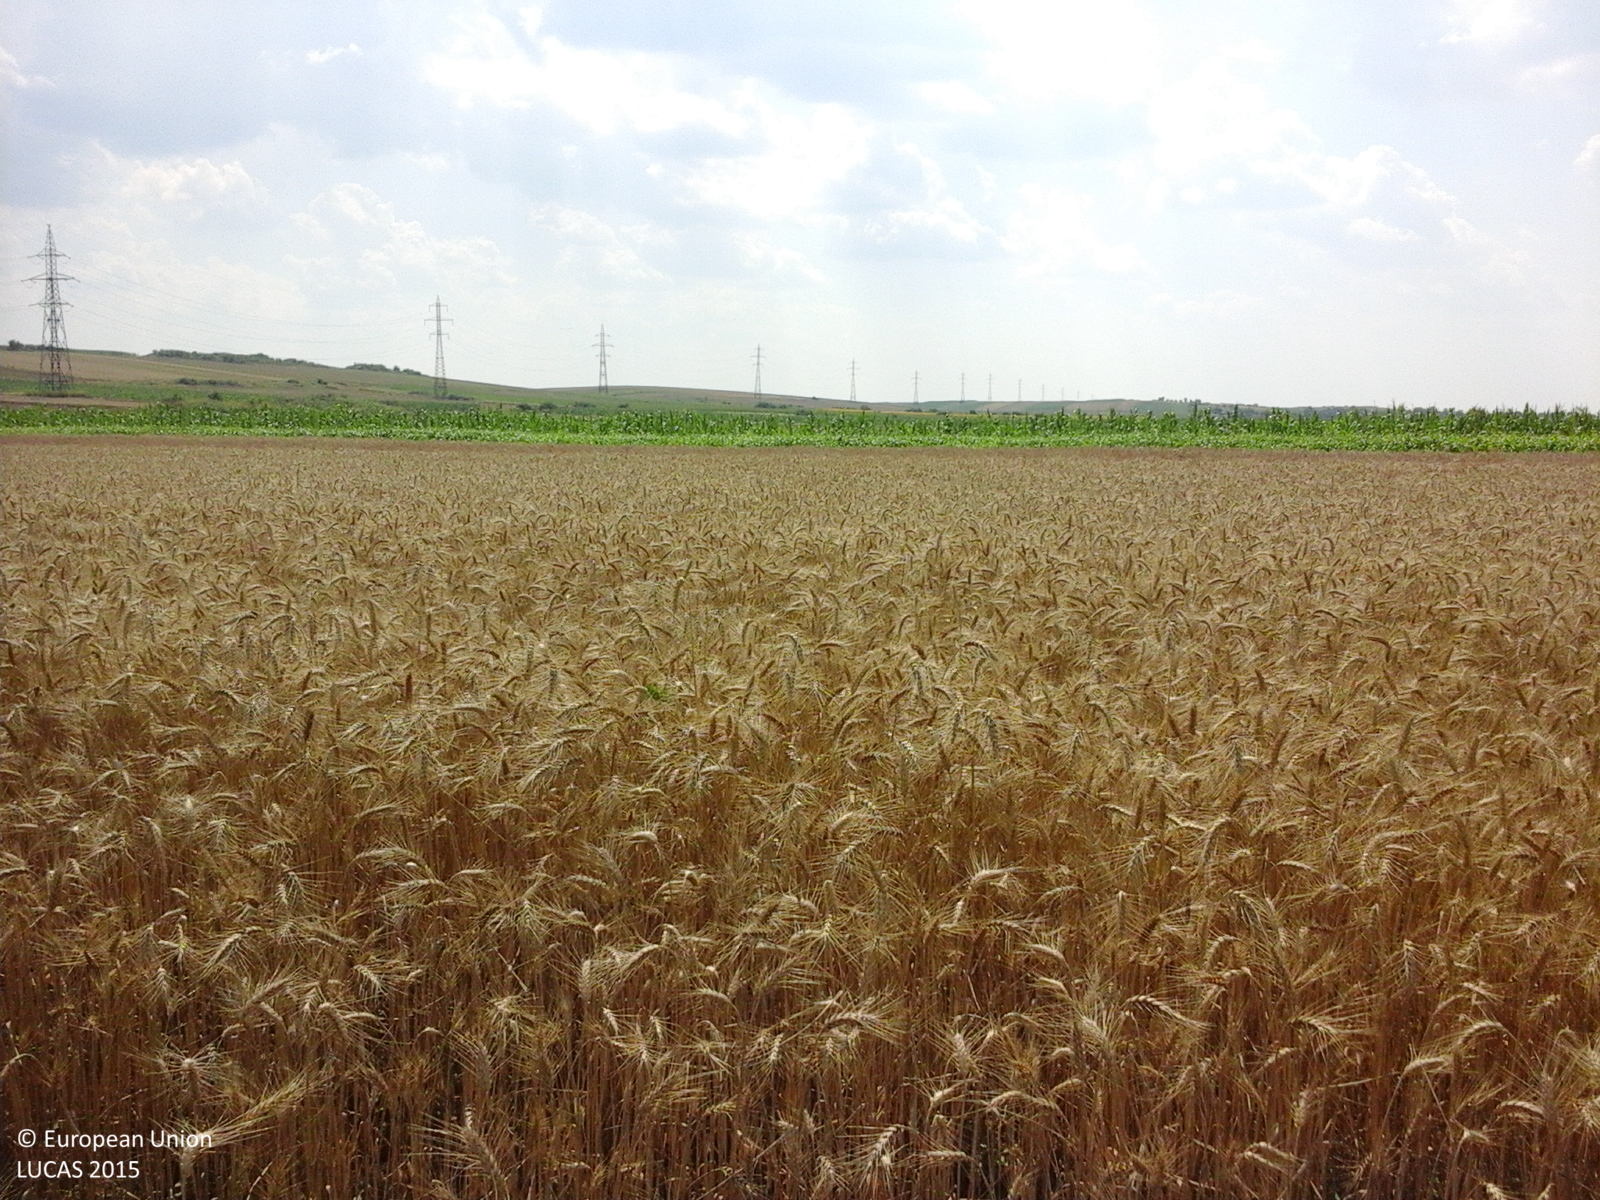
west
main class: Cropland
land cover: Common wheat
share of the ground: > 75 %
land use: Agriculture (excluding fallow land and kitchen gardens)
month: July
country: RO
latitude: 44.0132
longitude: 25.1858
